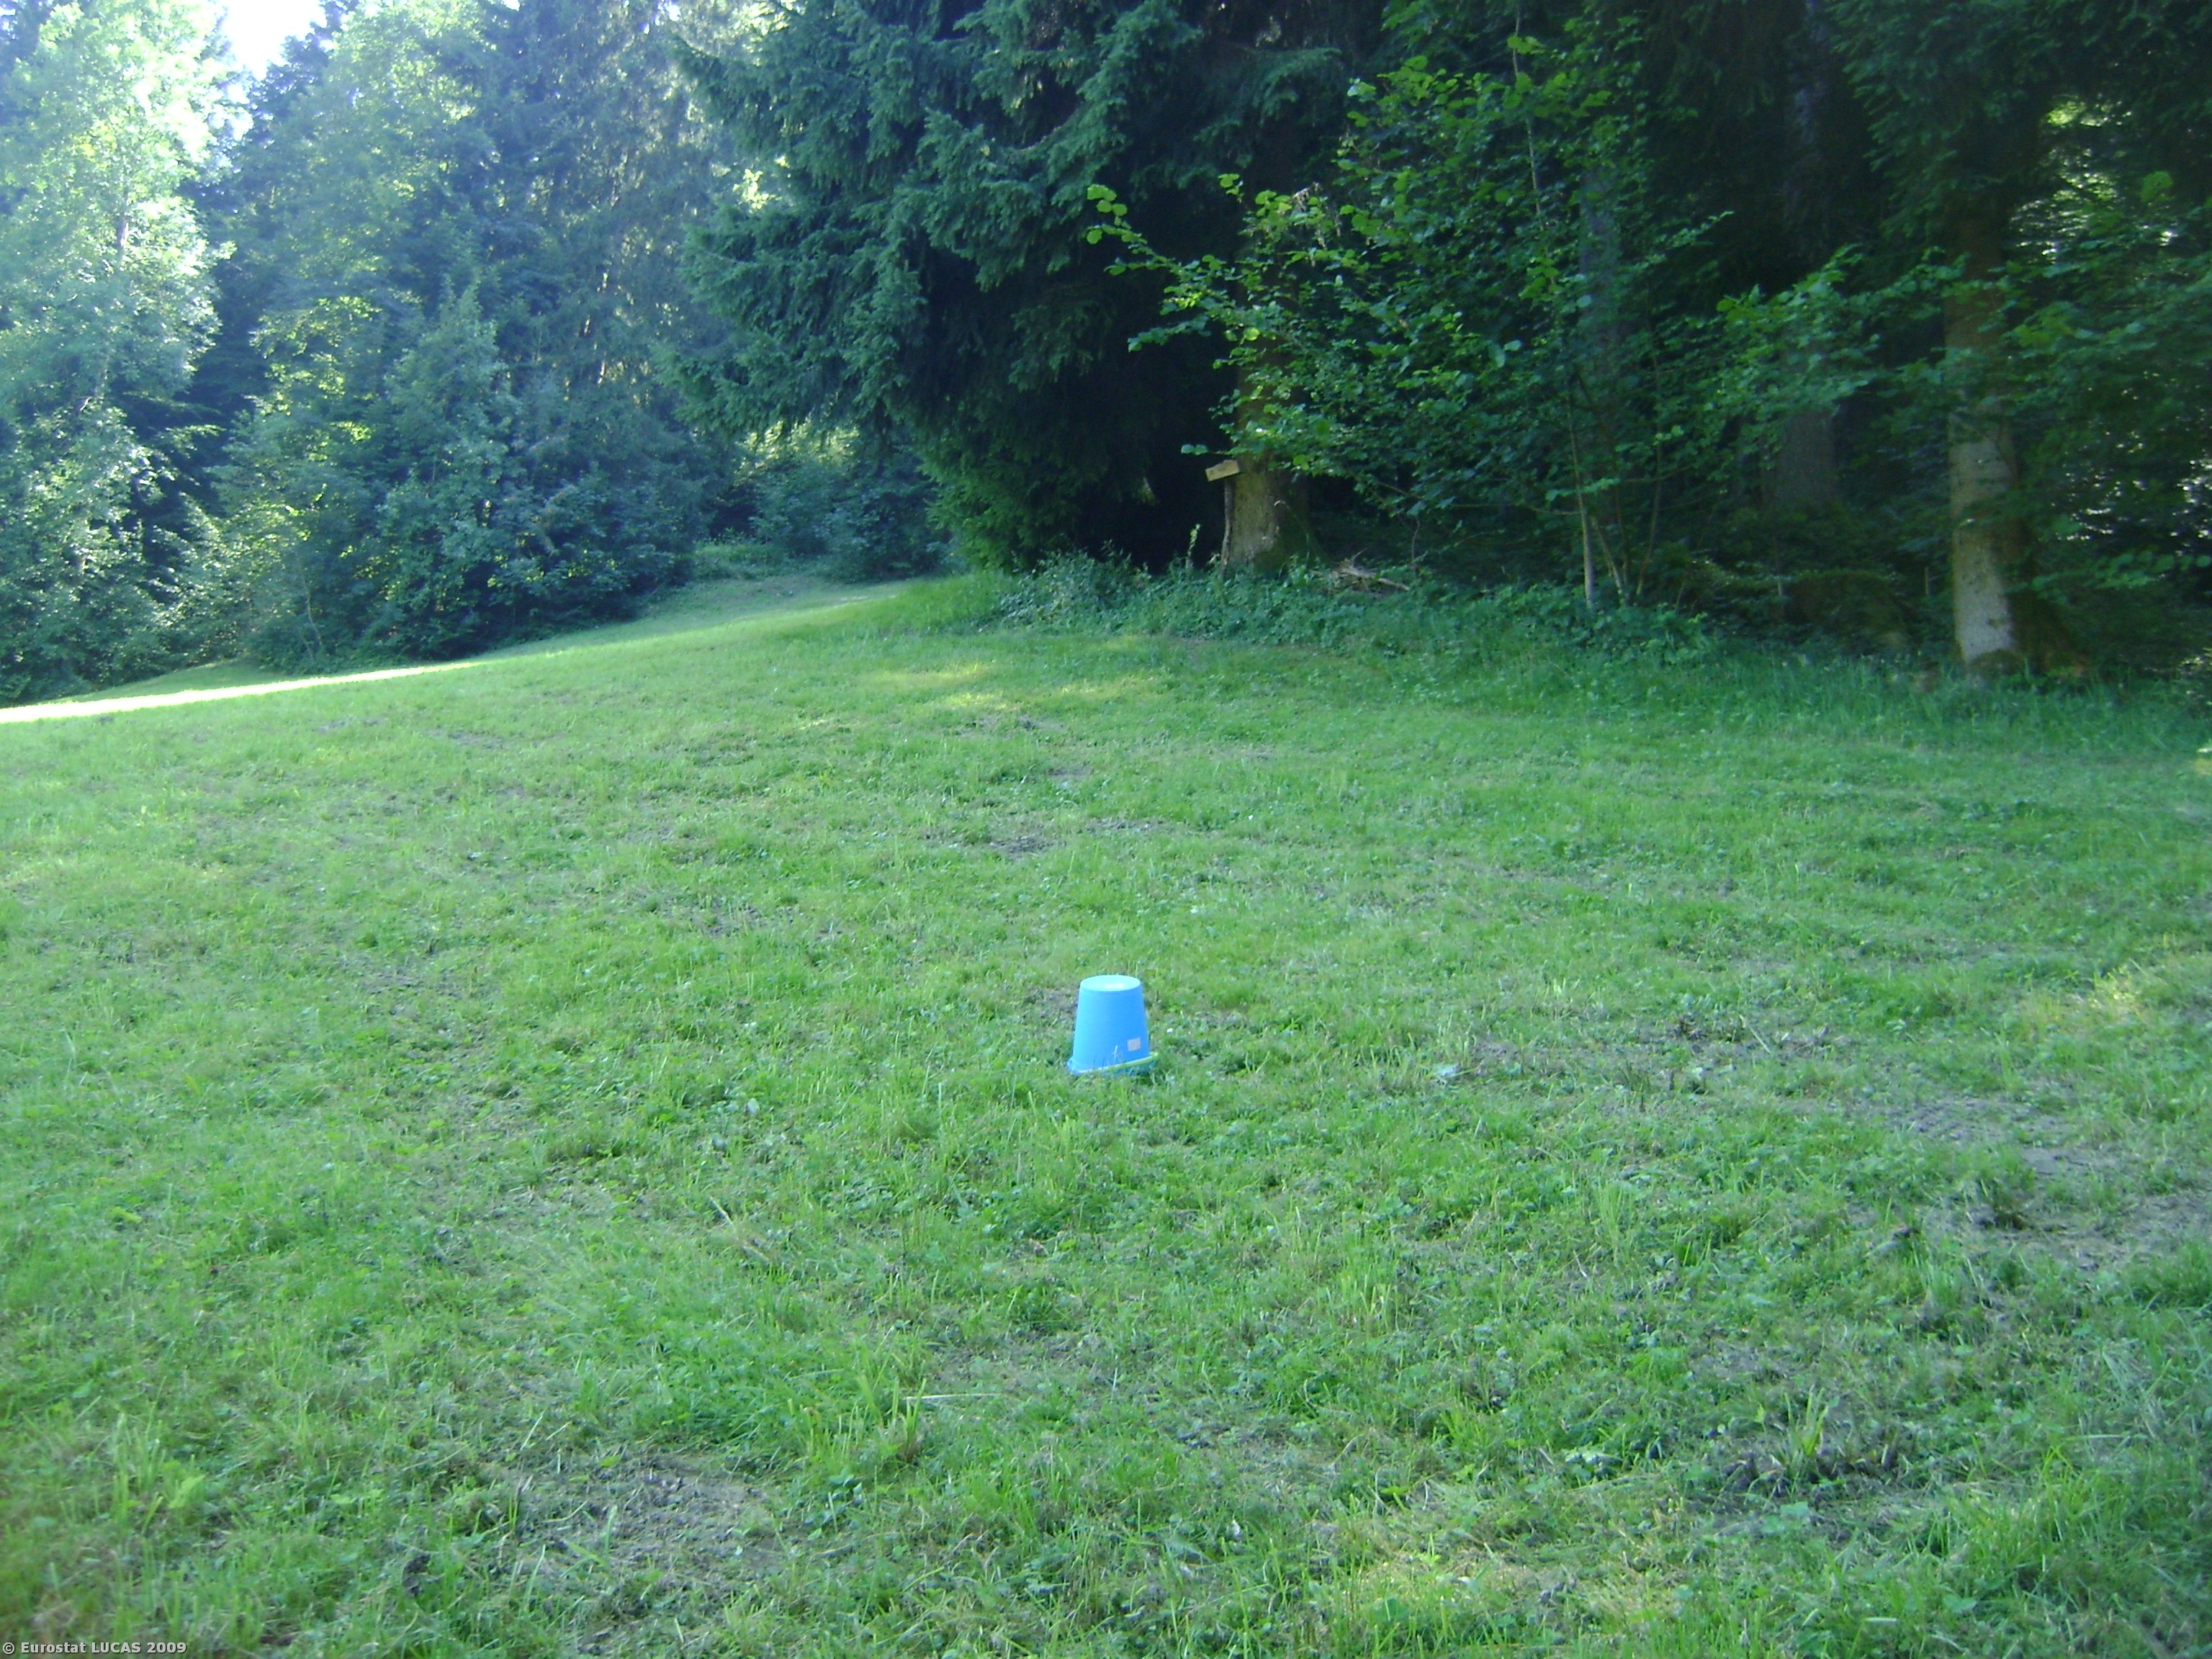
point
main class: Grassland
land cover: Grassland without tree/shrub cover
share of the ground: > 75 %
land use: Agriculture (excluding fallow land and kitchen gardens)
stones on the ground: < 10 %
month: August
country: AT
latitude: 47.4676
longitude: 9.9337
